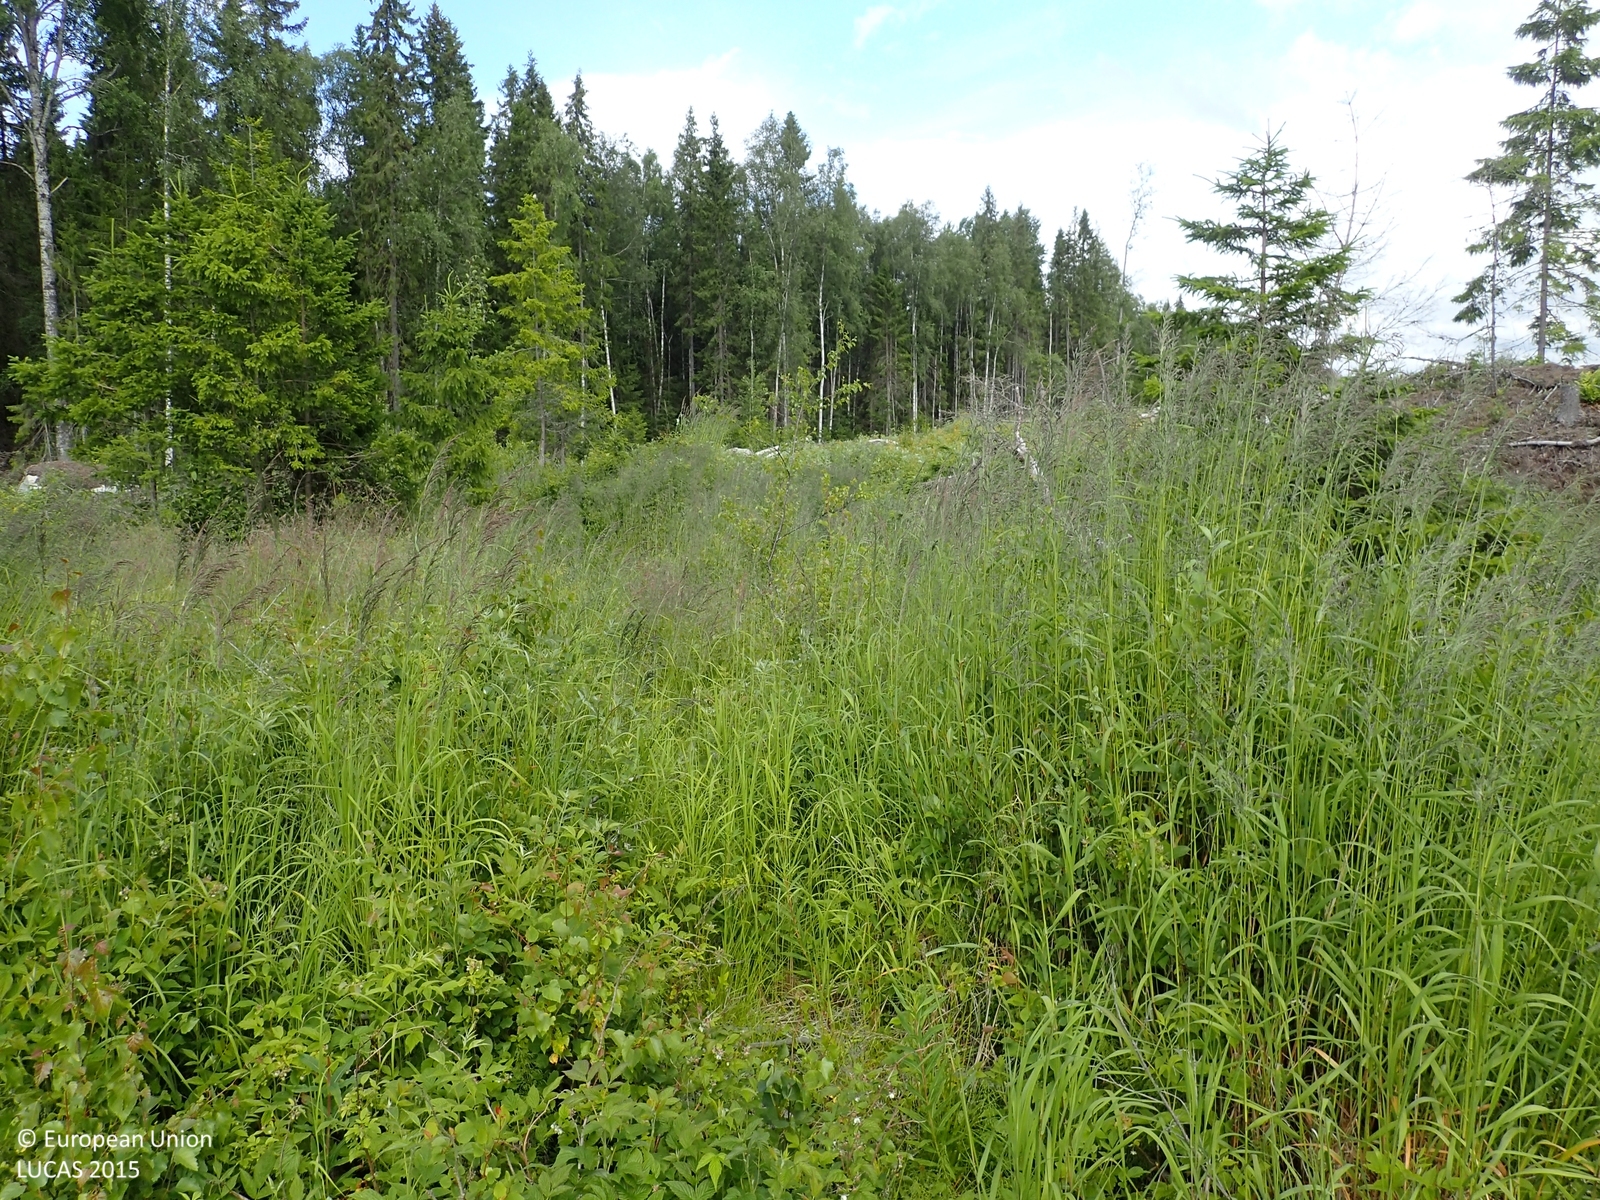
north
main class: Grassland
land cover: Grassland with sparse tree/shrub cover
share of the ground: > 75 %
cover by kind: herbaceous plants 90 %, broadleaved forest trees 5 %, consolidated bare surface 5 %
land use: Forestry
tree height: < 5 m
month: July
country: FI
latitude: 62.9234
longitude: 21.4412
